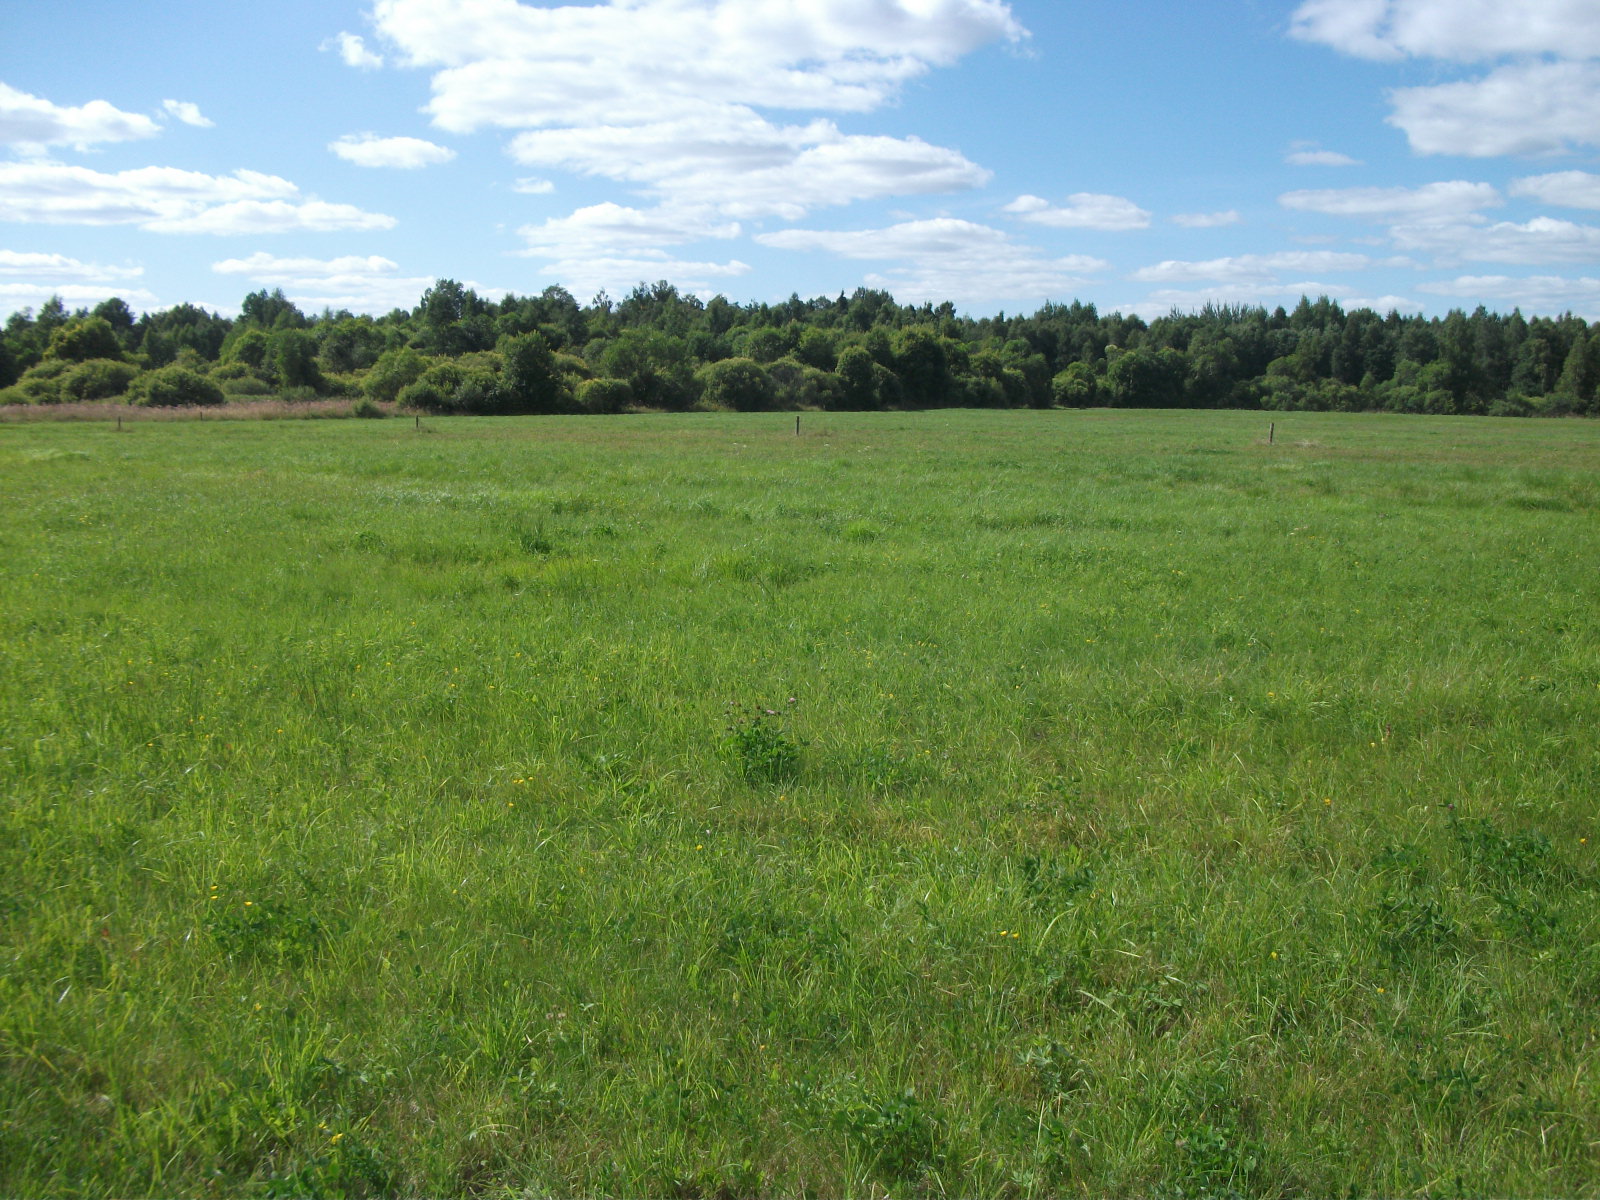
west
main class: Grassland
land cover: Grassland without tree/shrub cover
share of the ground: > 75 %
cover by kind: herbaceous plants 100 %
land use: Agriculture (excluding fallow land and kitchen gardens)
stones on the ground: < 10 %
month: August
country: LV
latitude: 56.4310
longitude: 26.3766
